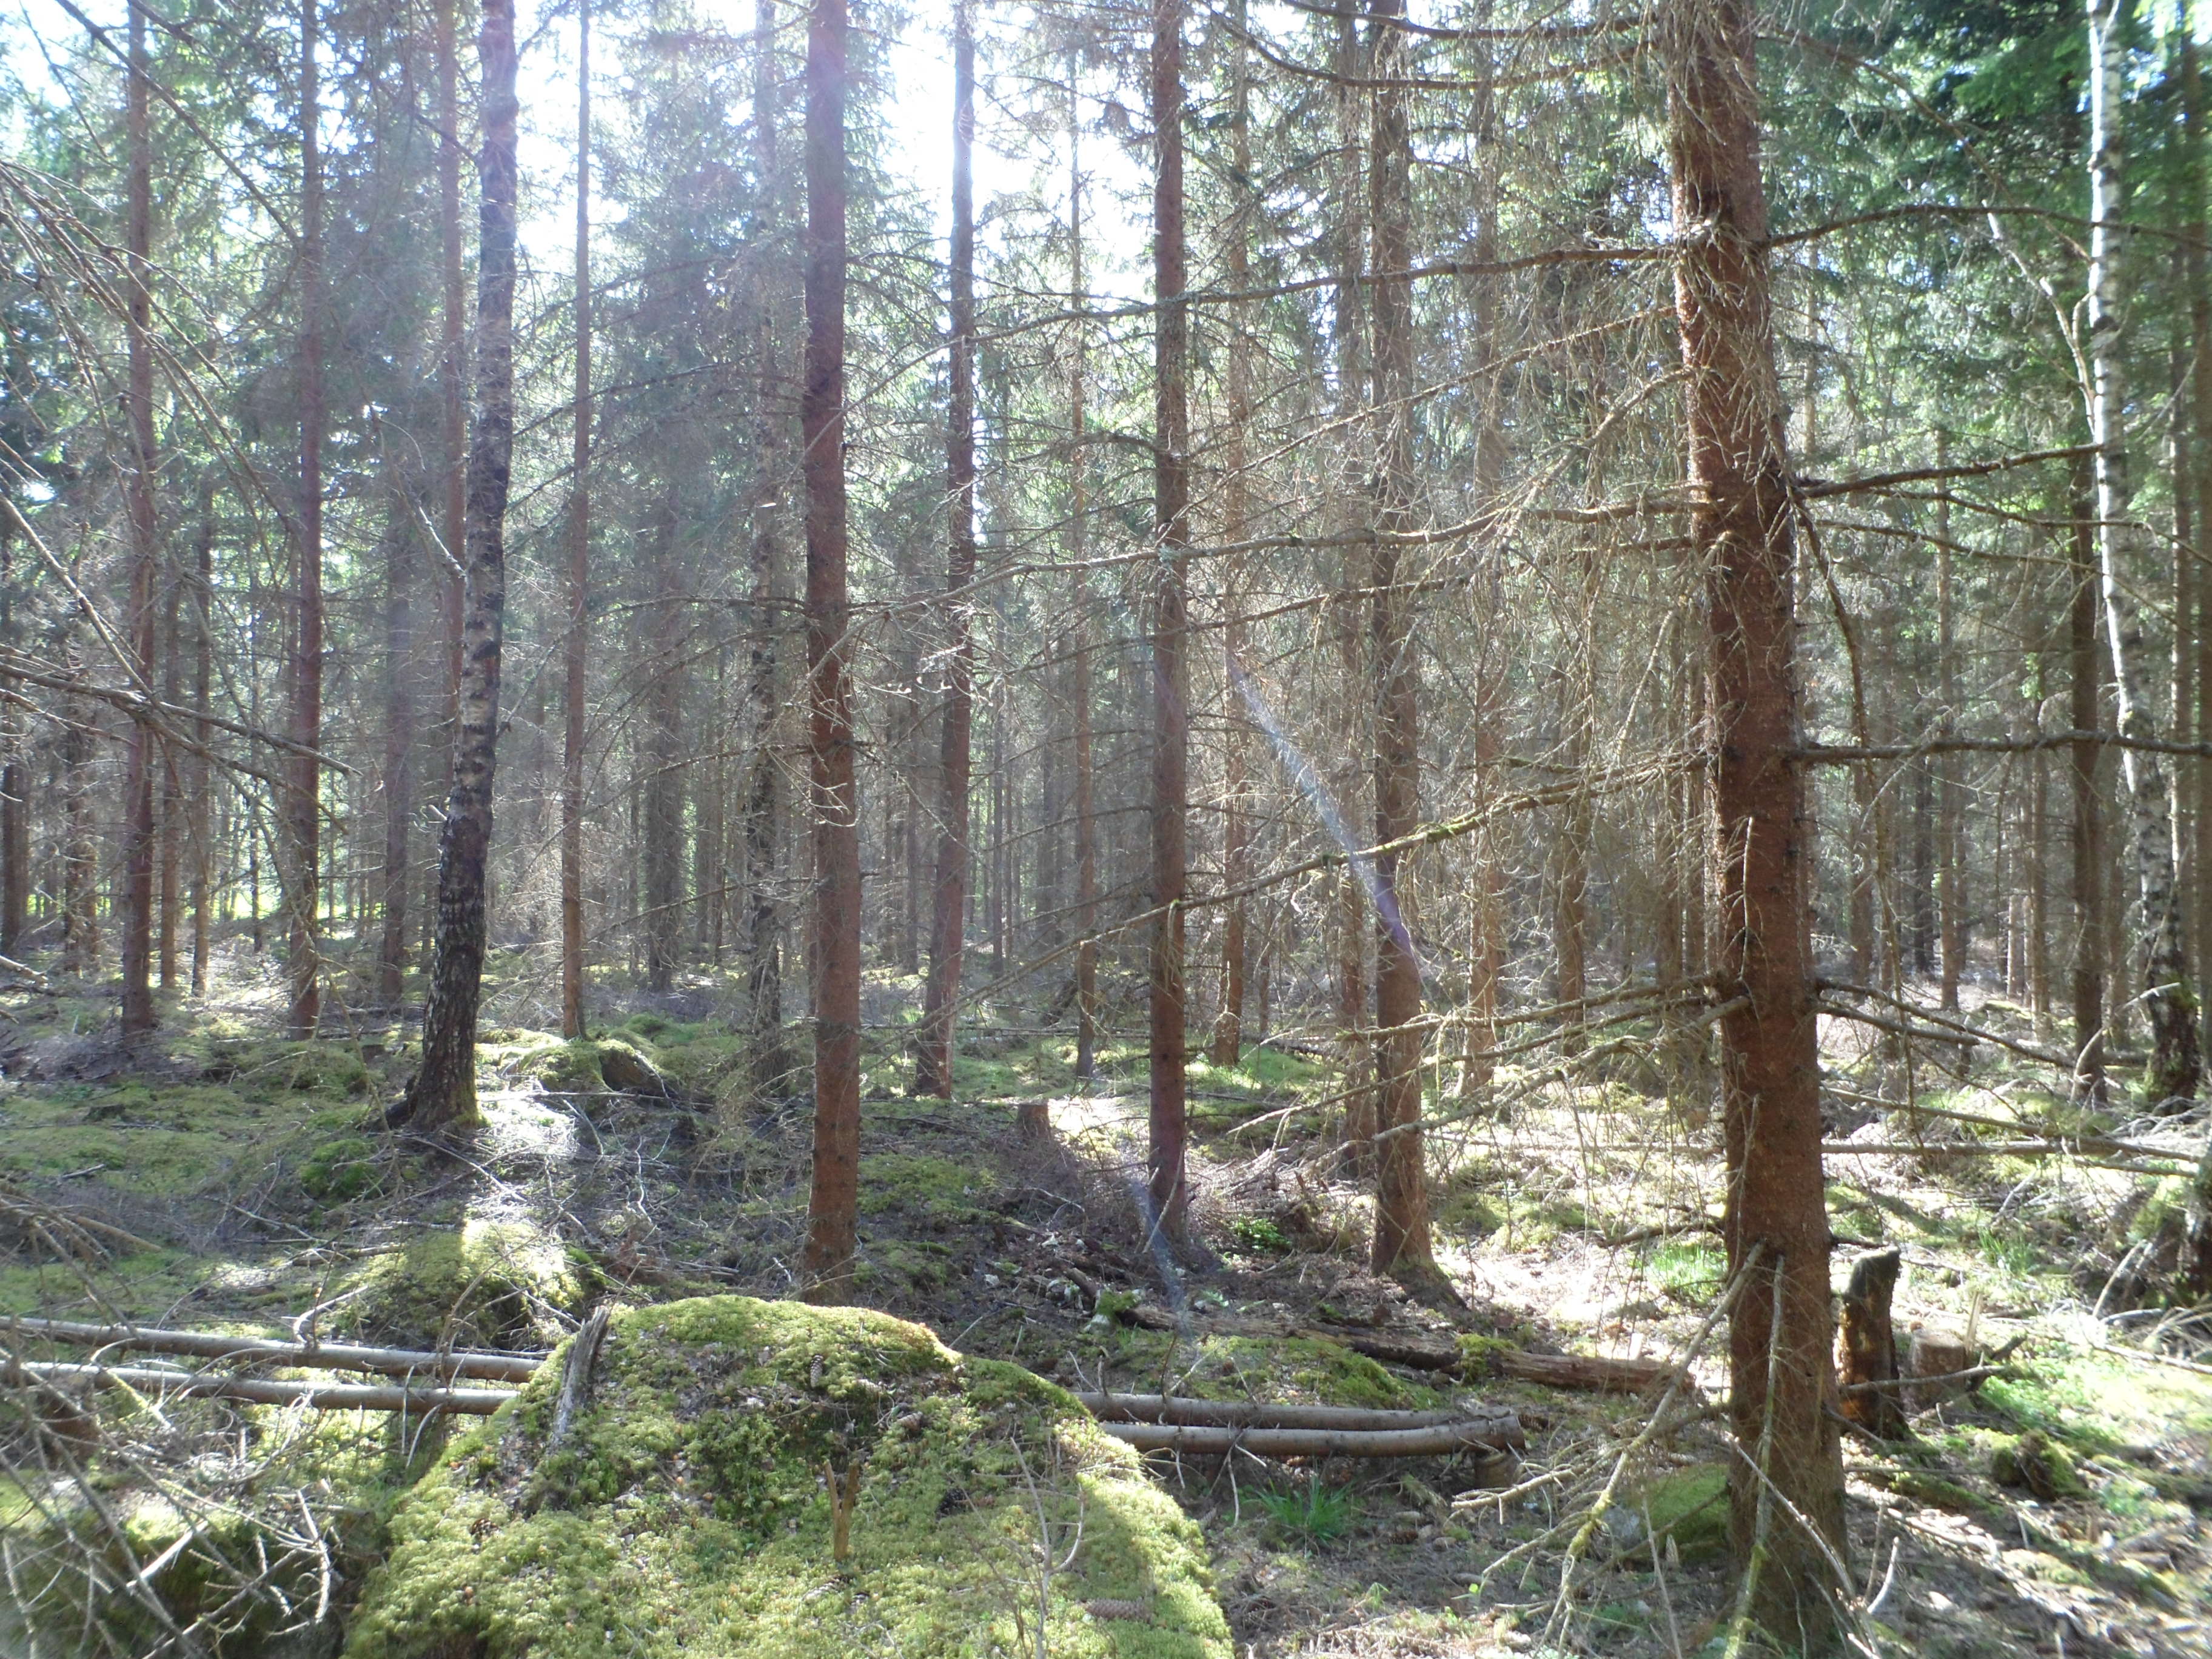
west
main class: Woodland
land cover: Spruce dominated coniferous woodland
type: boreal forest
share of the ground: 50 - 75 %
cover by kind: coniferous forest trees 65 %, lichens and mosses 25 %, broadleaved forest trees 5 %, herbaceous plants 5 %
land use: Forestry
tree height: > 5 m
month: June
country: SE
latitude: 56.9609
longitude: 14.8484
